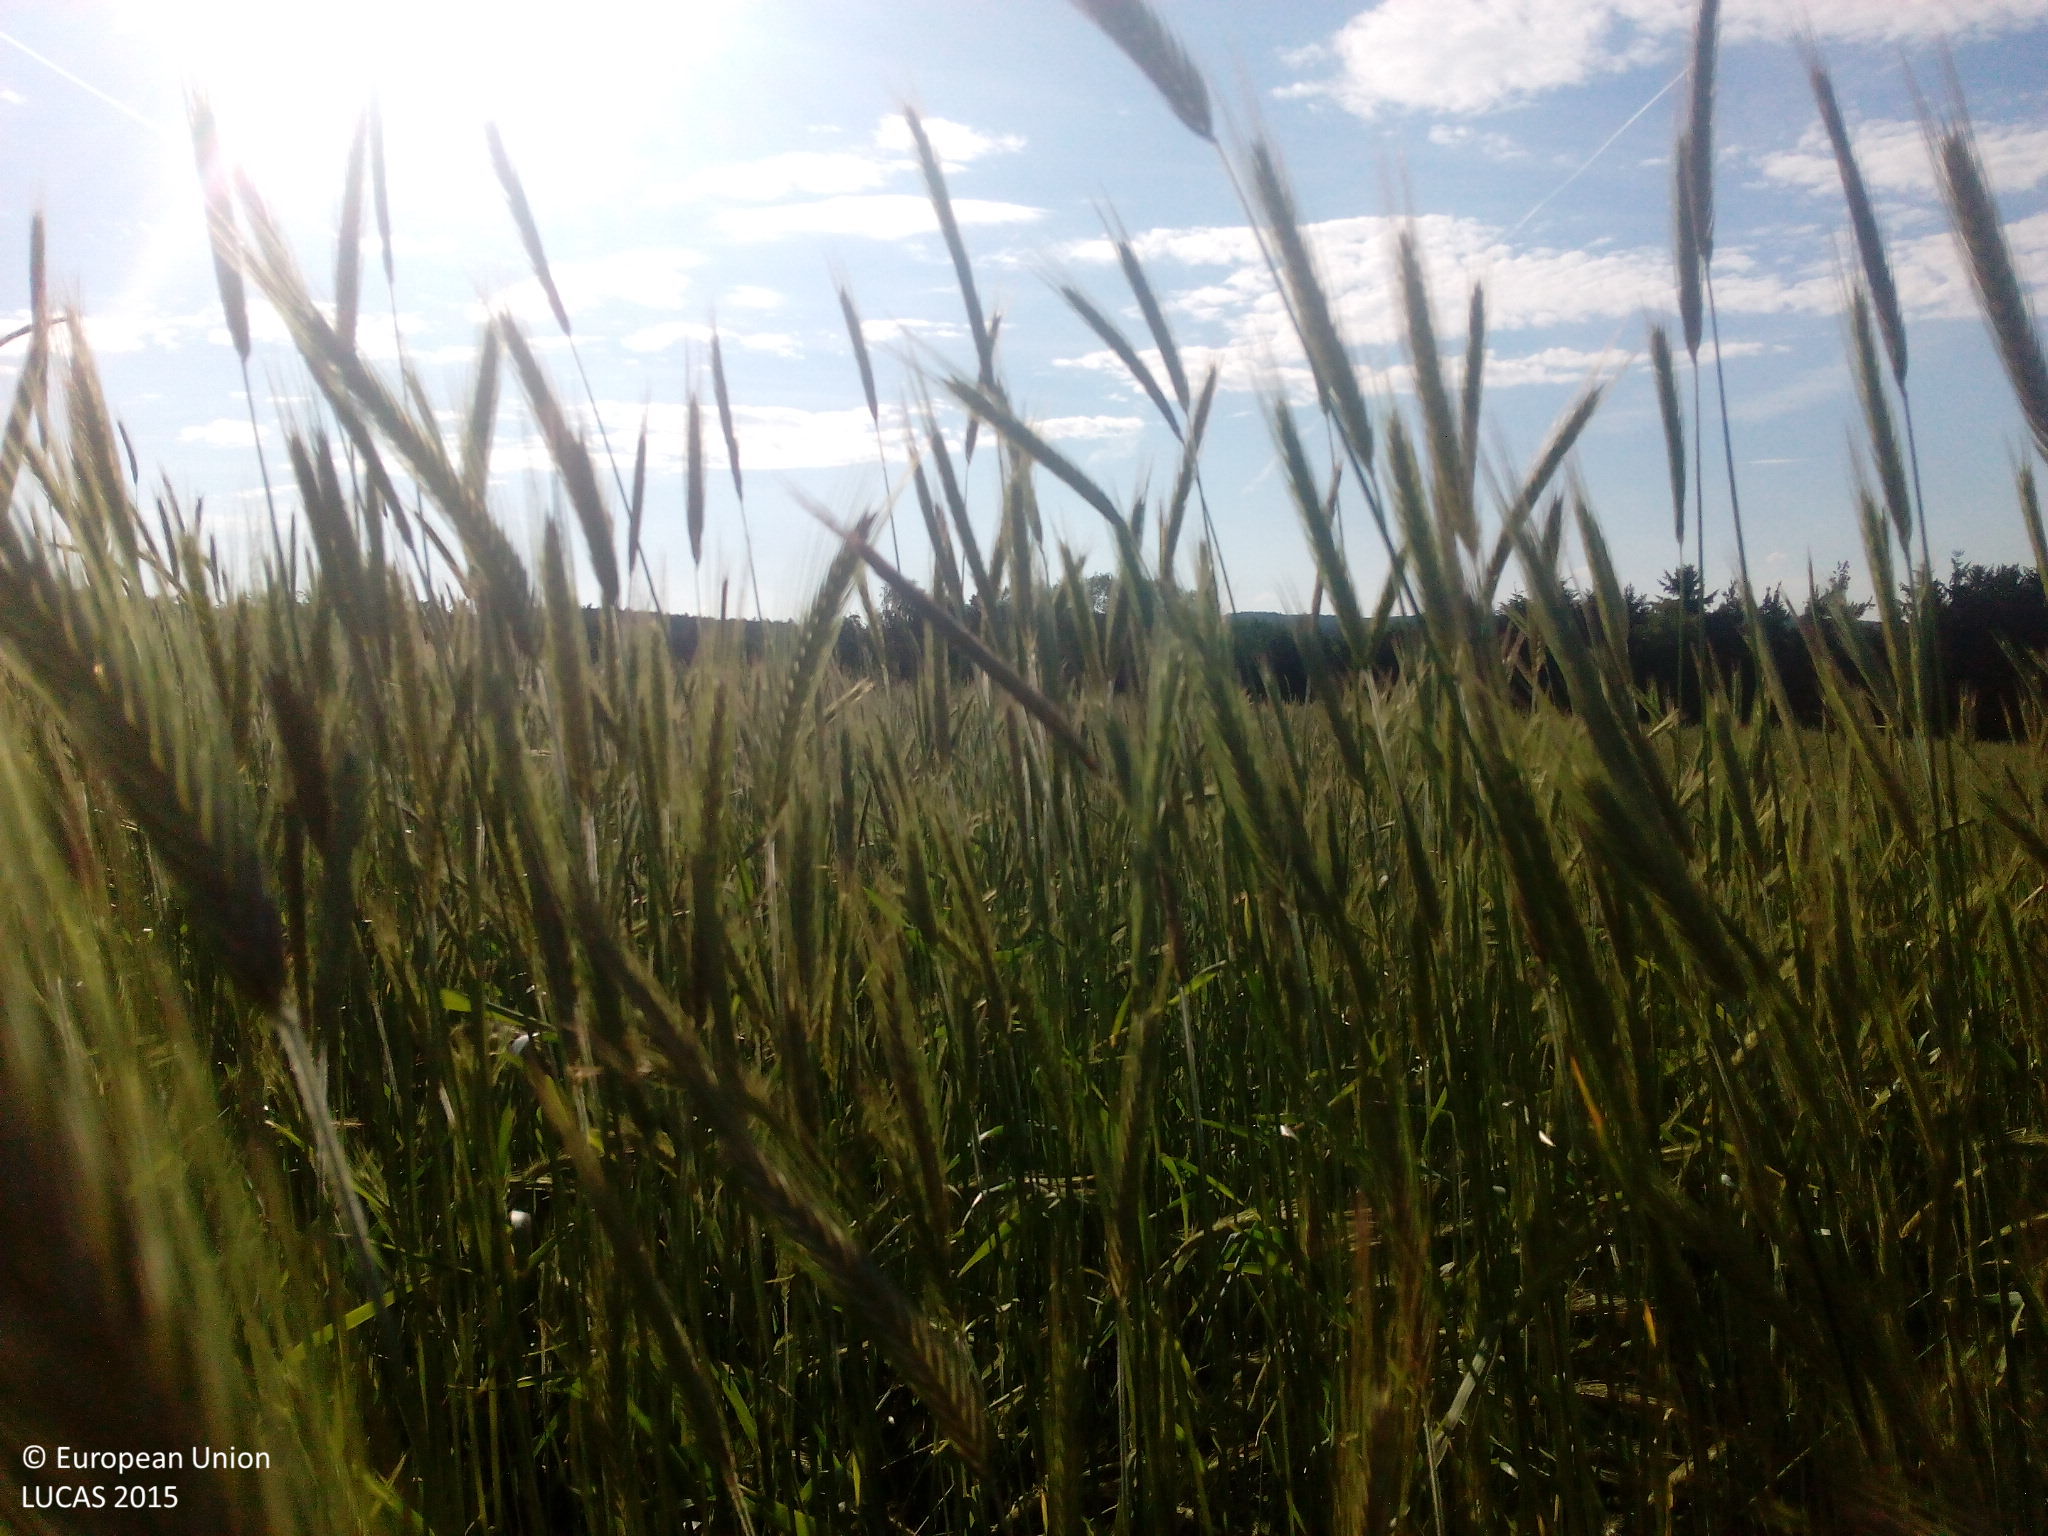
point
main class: Cropland
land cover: Rye
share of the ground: > 75 %
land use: Agriculture (excluding fallow land and kitchen gardens)
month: June
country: DE
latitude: 49.3503
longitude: 12.3535
